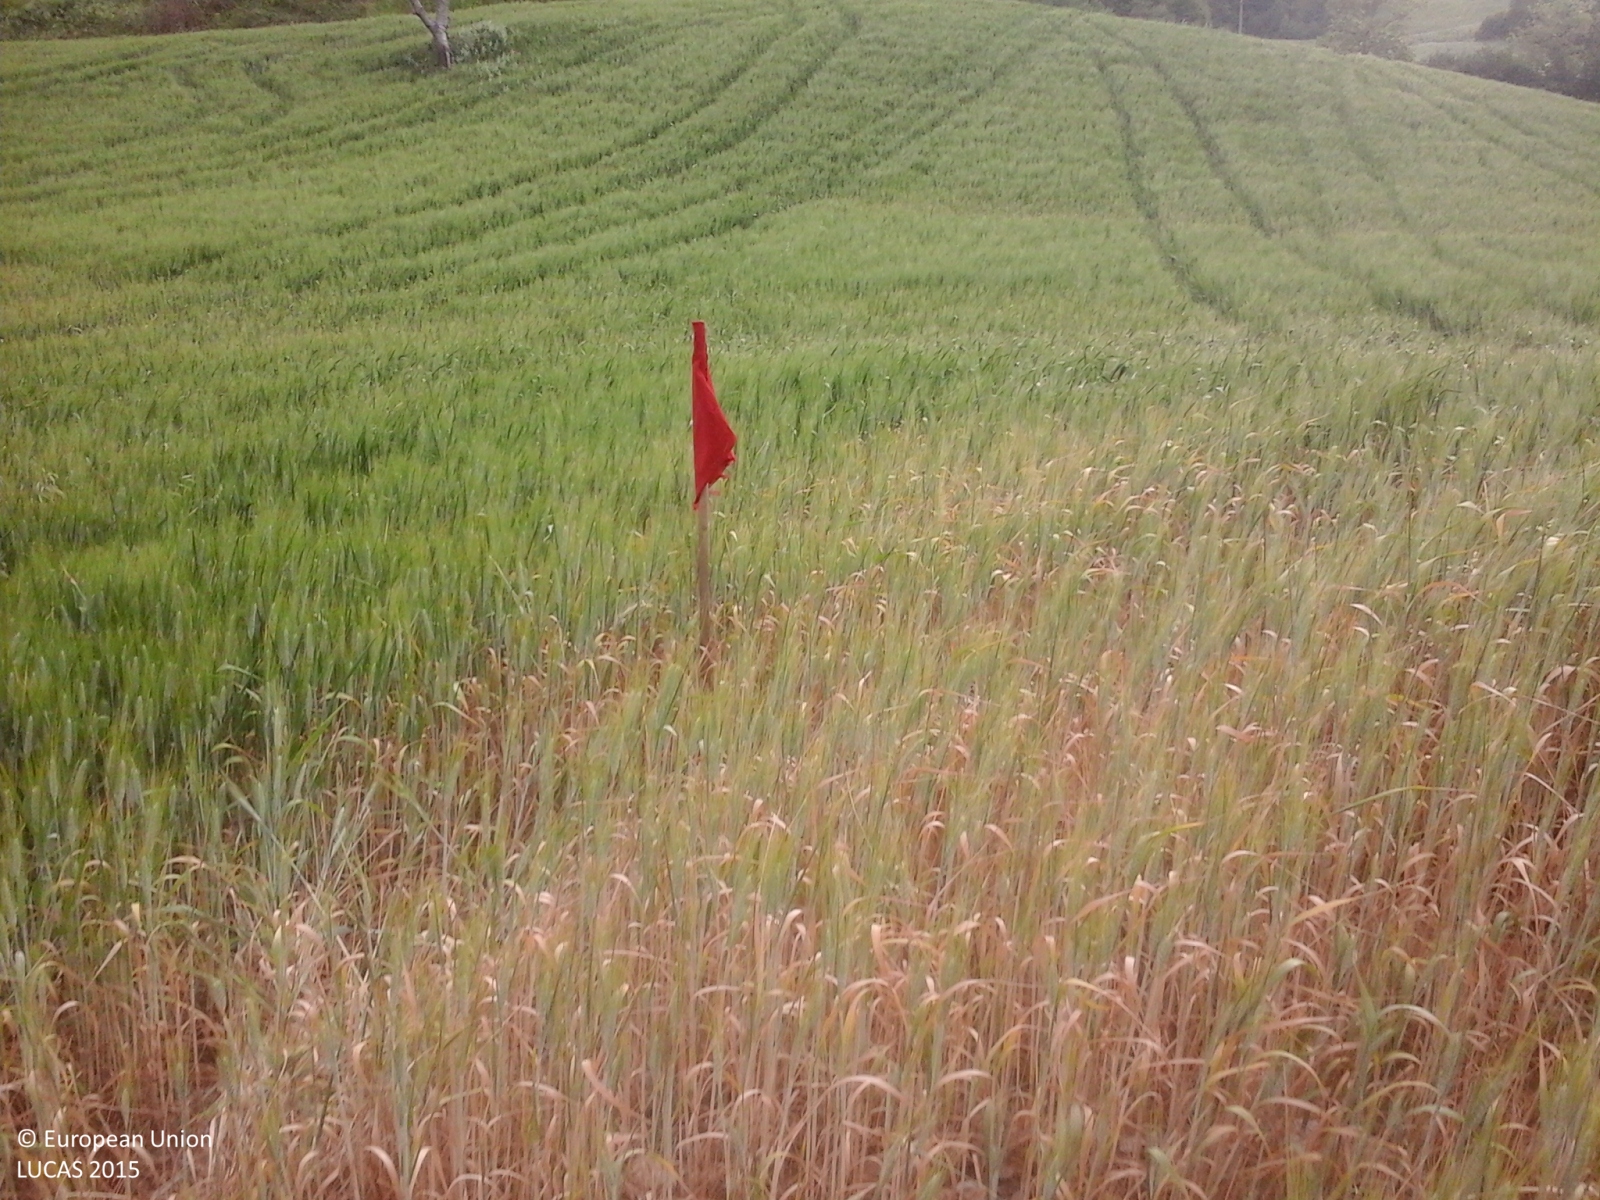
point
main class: Cropland
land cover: Durum wheat
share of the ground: > 75 %
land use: Agriculture (excluding fallow land and kitchen gardens)
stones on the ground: > 50 %
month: May
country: IT
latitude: 41.3713
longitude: 15.0157
